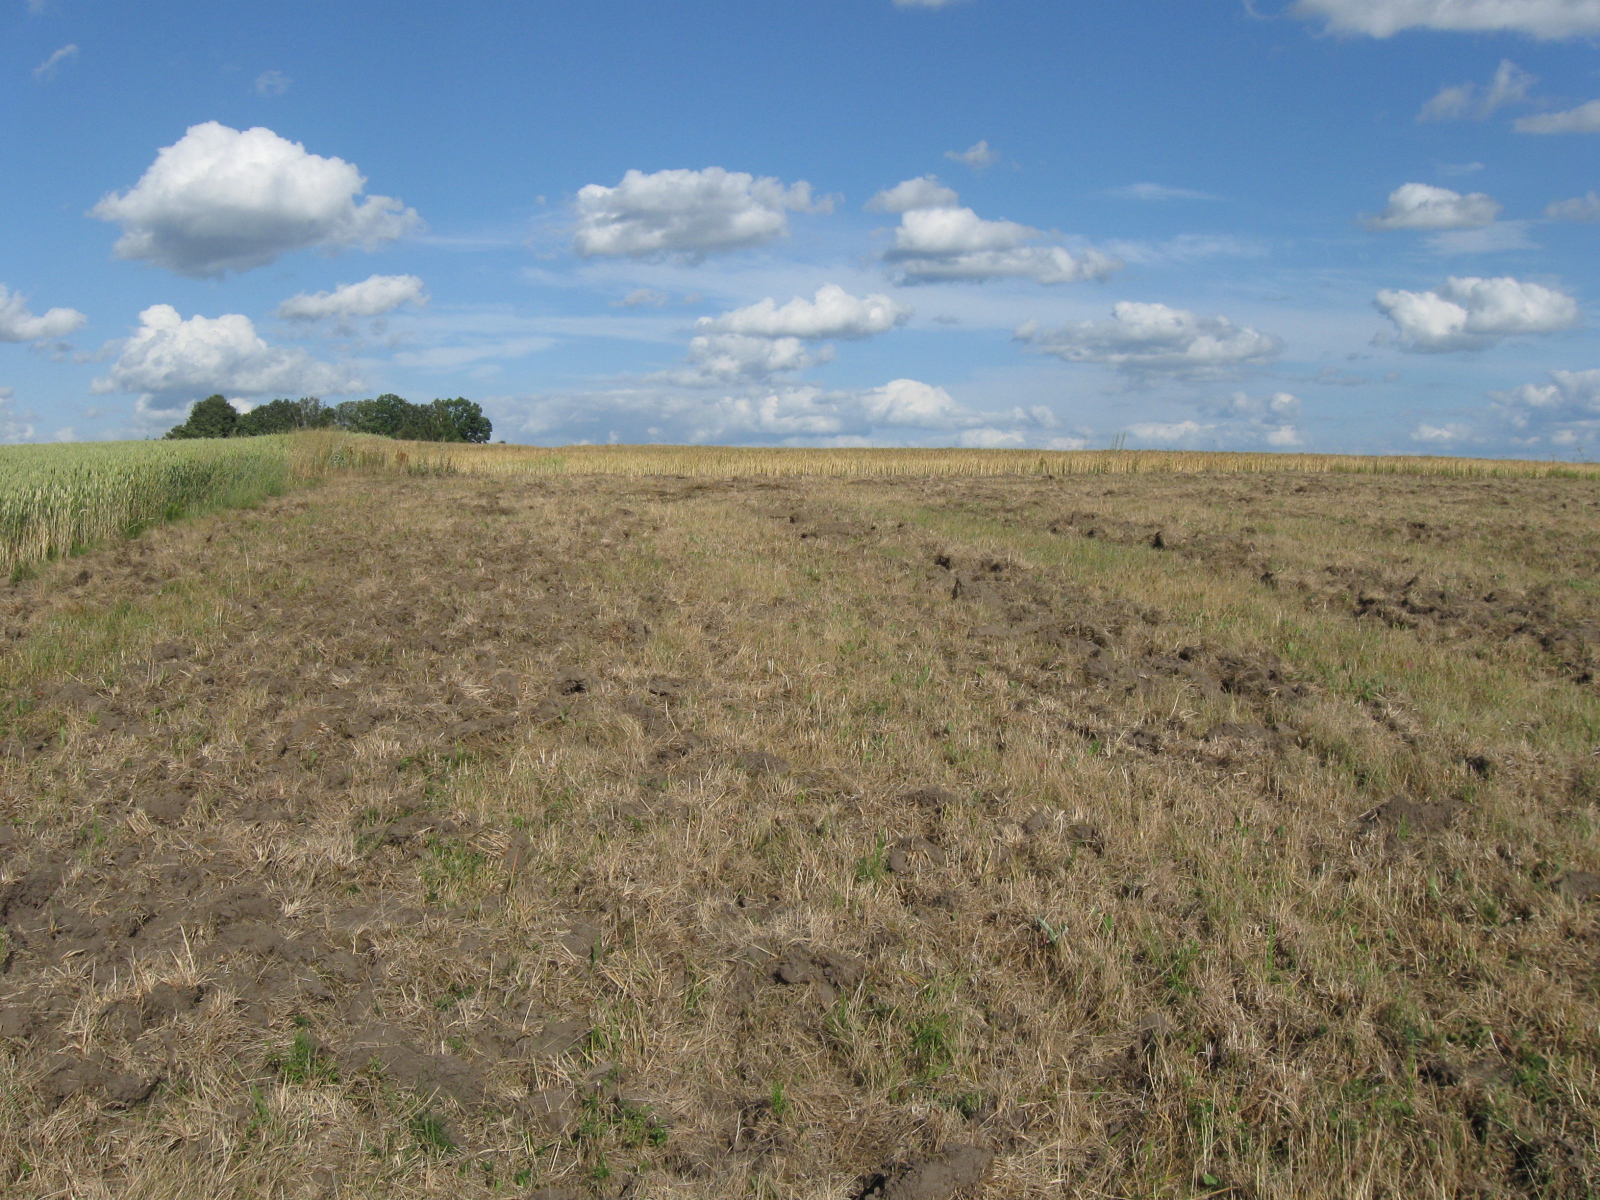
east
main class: Grassland
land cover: Spontaneously vegetated surfaces
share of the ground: 50 - 75 %
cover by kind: unconsolidated bare surface 85 %, herbaceous plants 15 %
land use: Fallow land
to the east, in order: Spontaneously vegetated surfaces; Barley
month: July
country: LT
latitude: 54.3405
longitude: 23.4791
